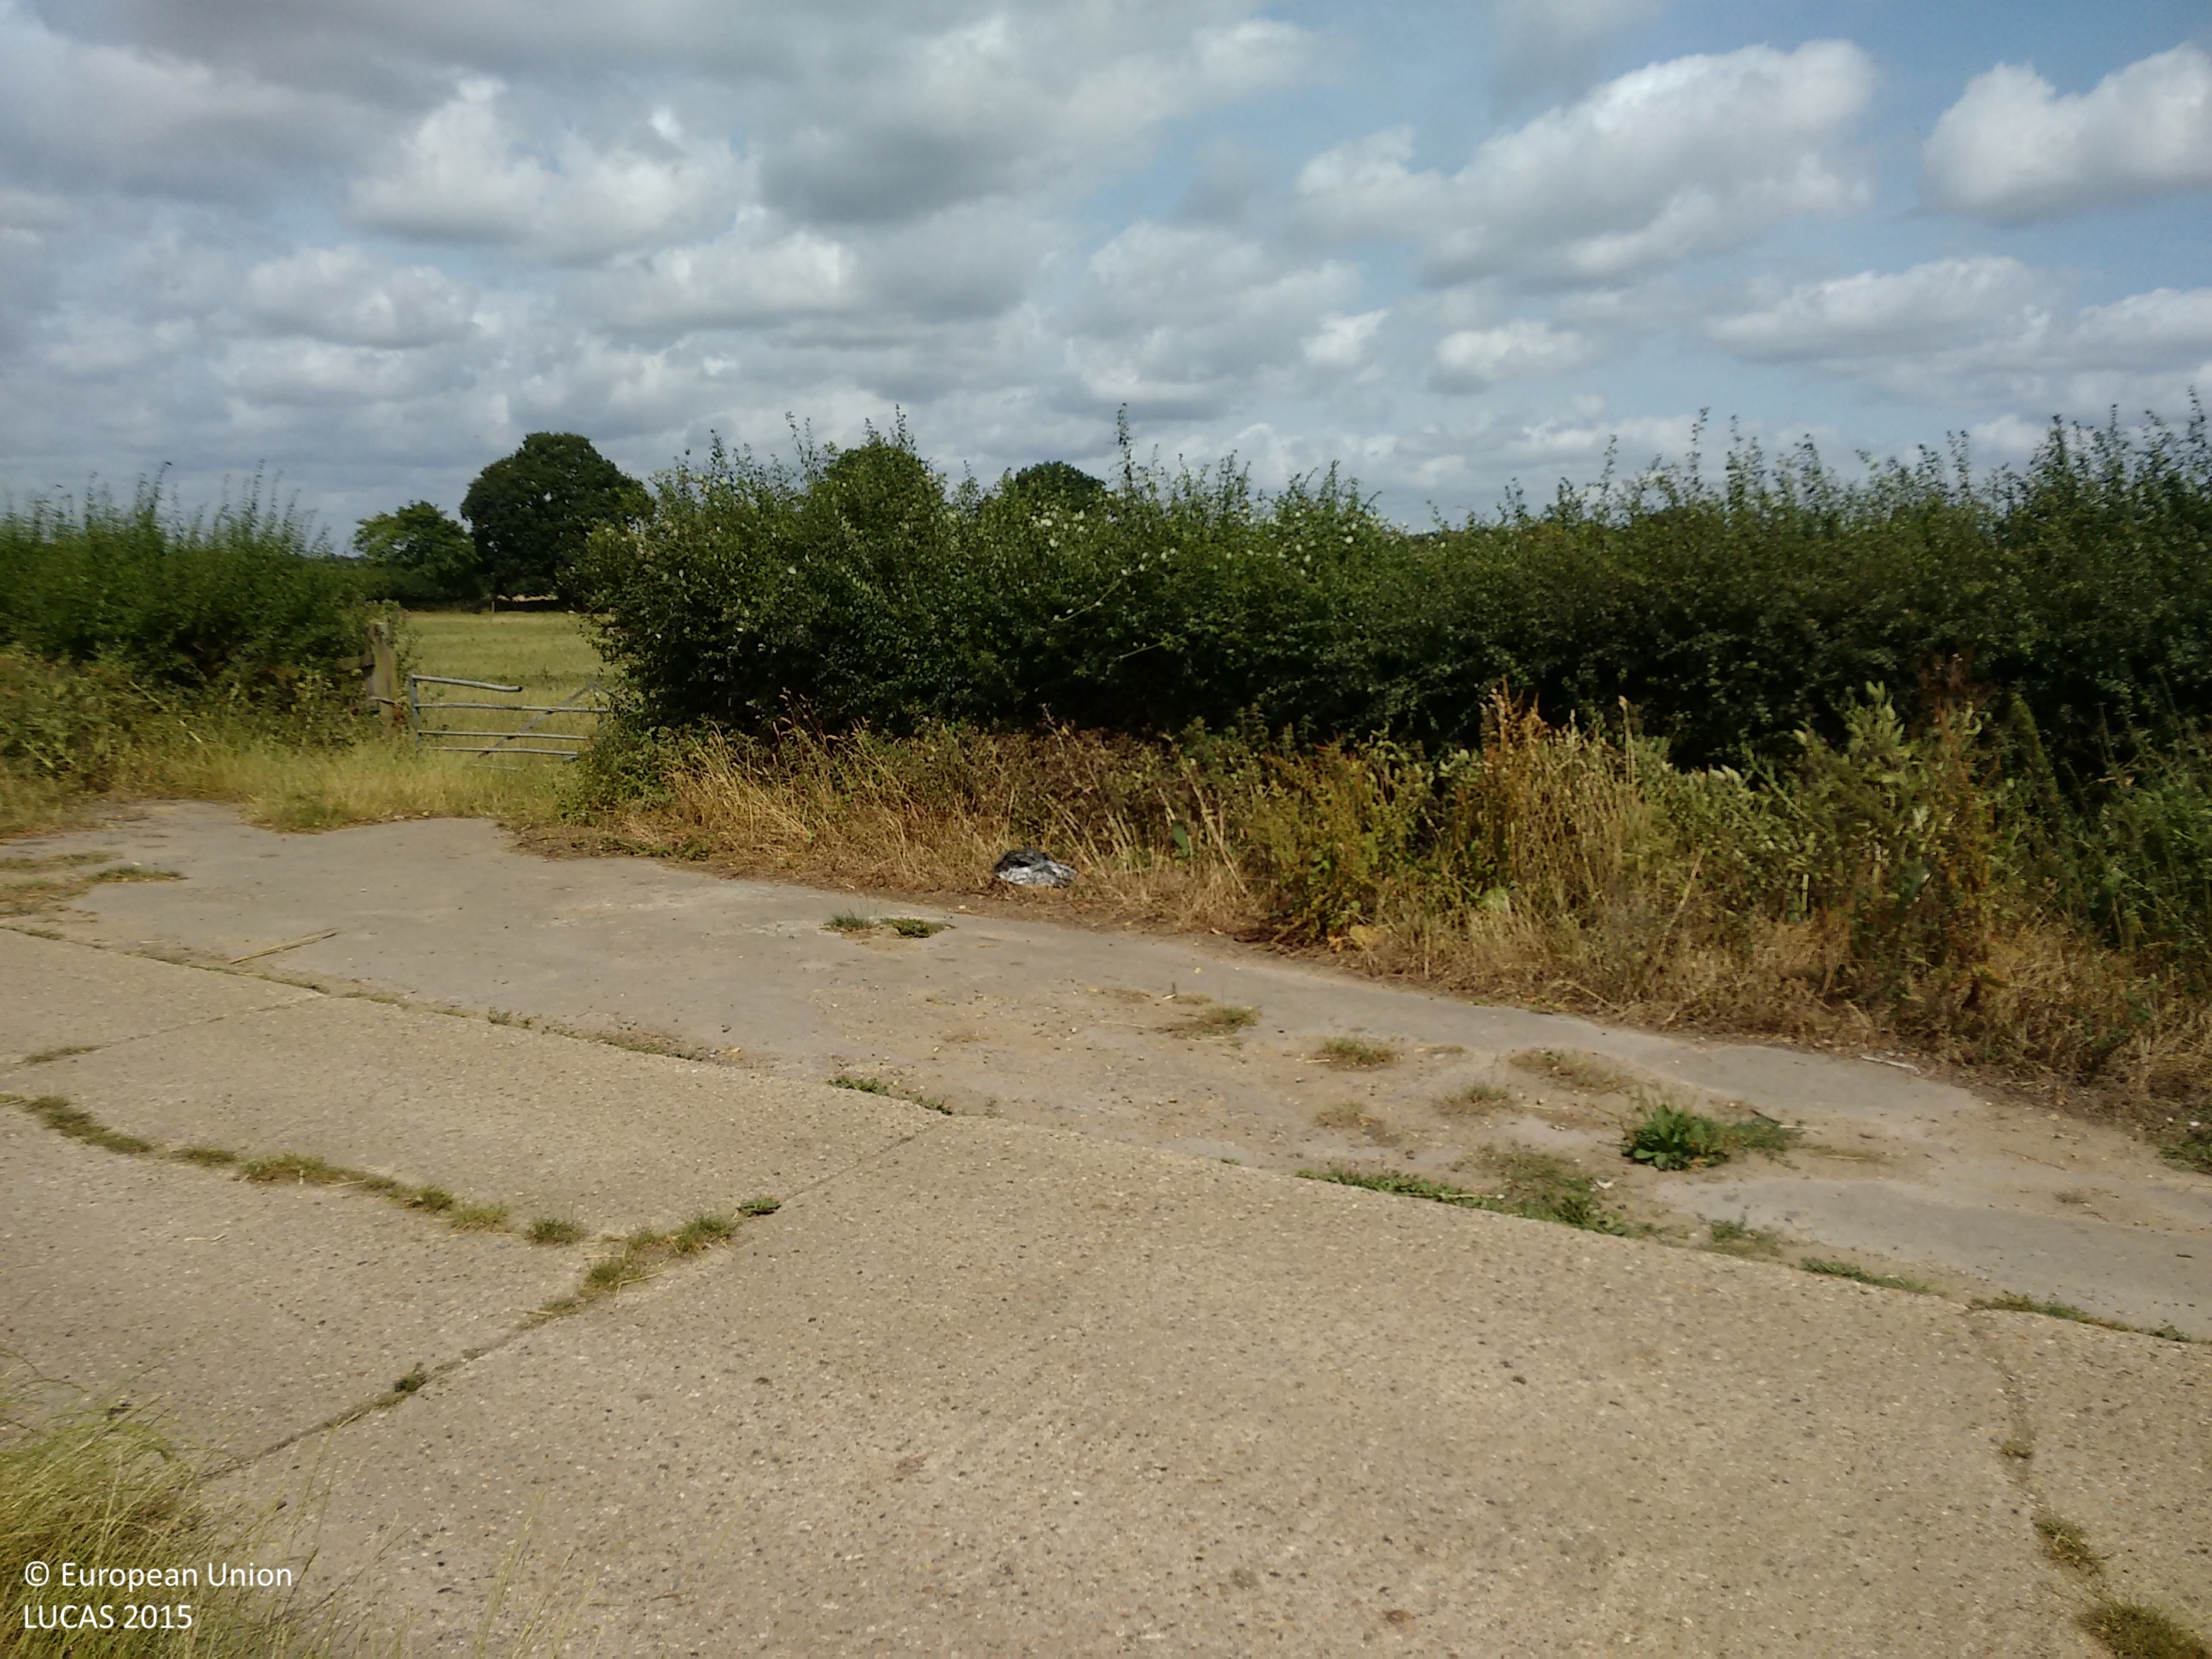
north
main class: Grassland
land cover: Grassland without tree/shrub cover
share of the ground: > 75 %
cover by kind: herbaceous plants 100 %
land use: Agriculture (excluding fallow land and kitchen gardens)
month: July
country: GB
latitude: 51.2768
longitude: -0.4887
